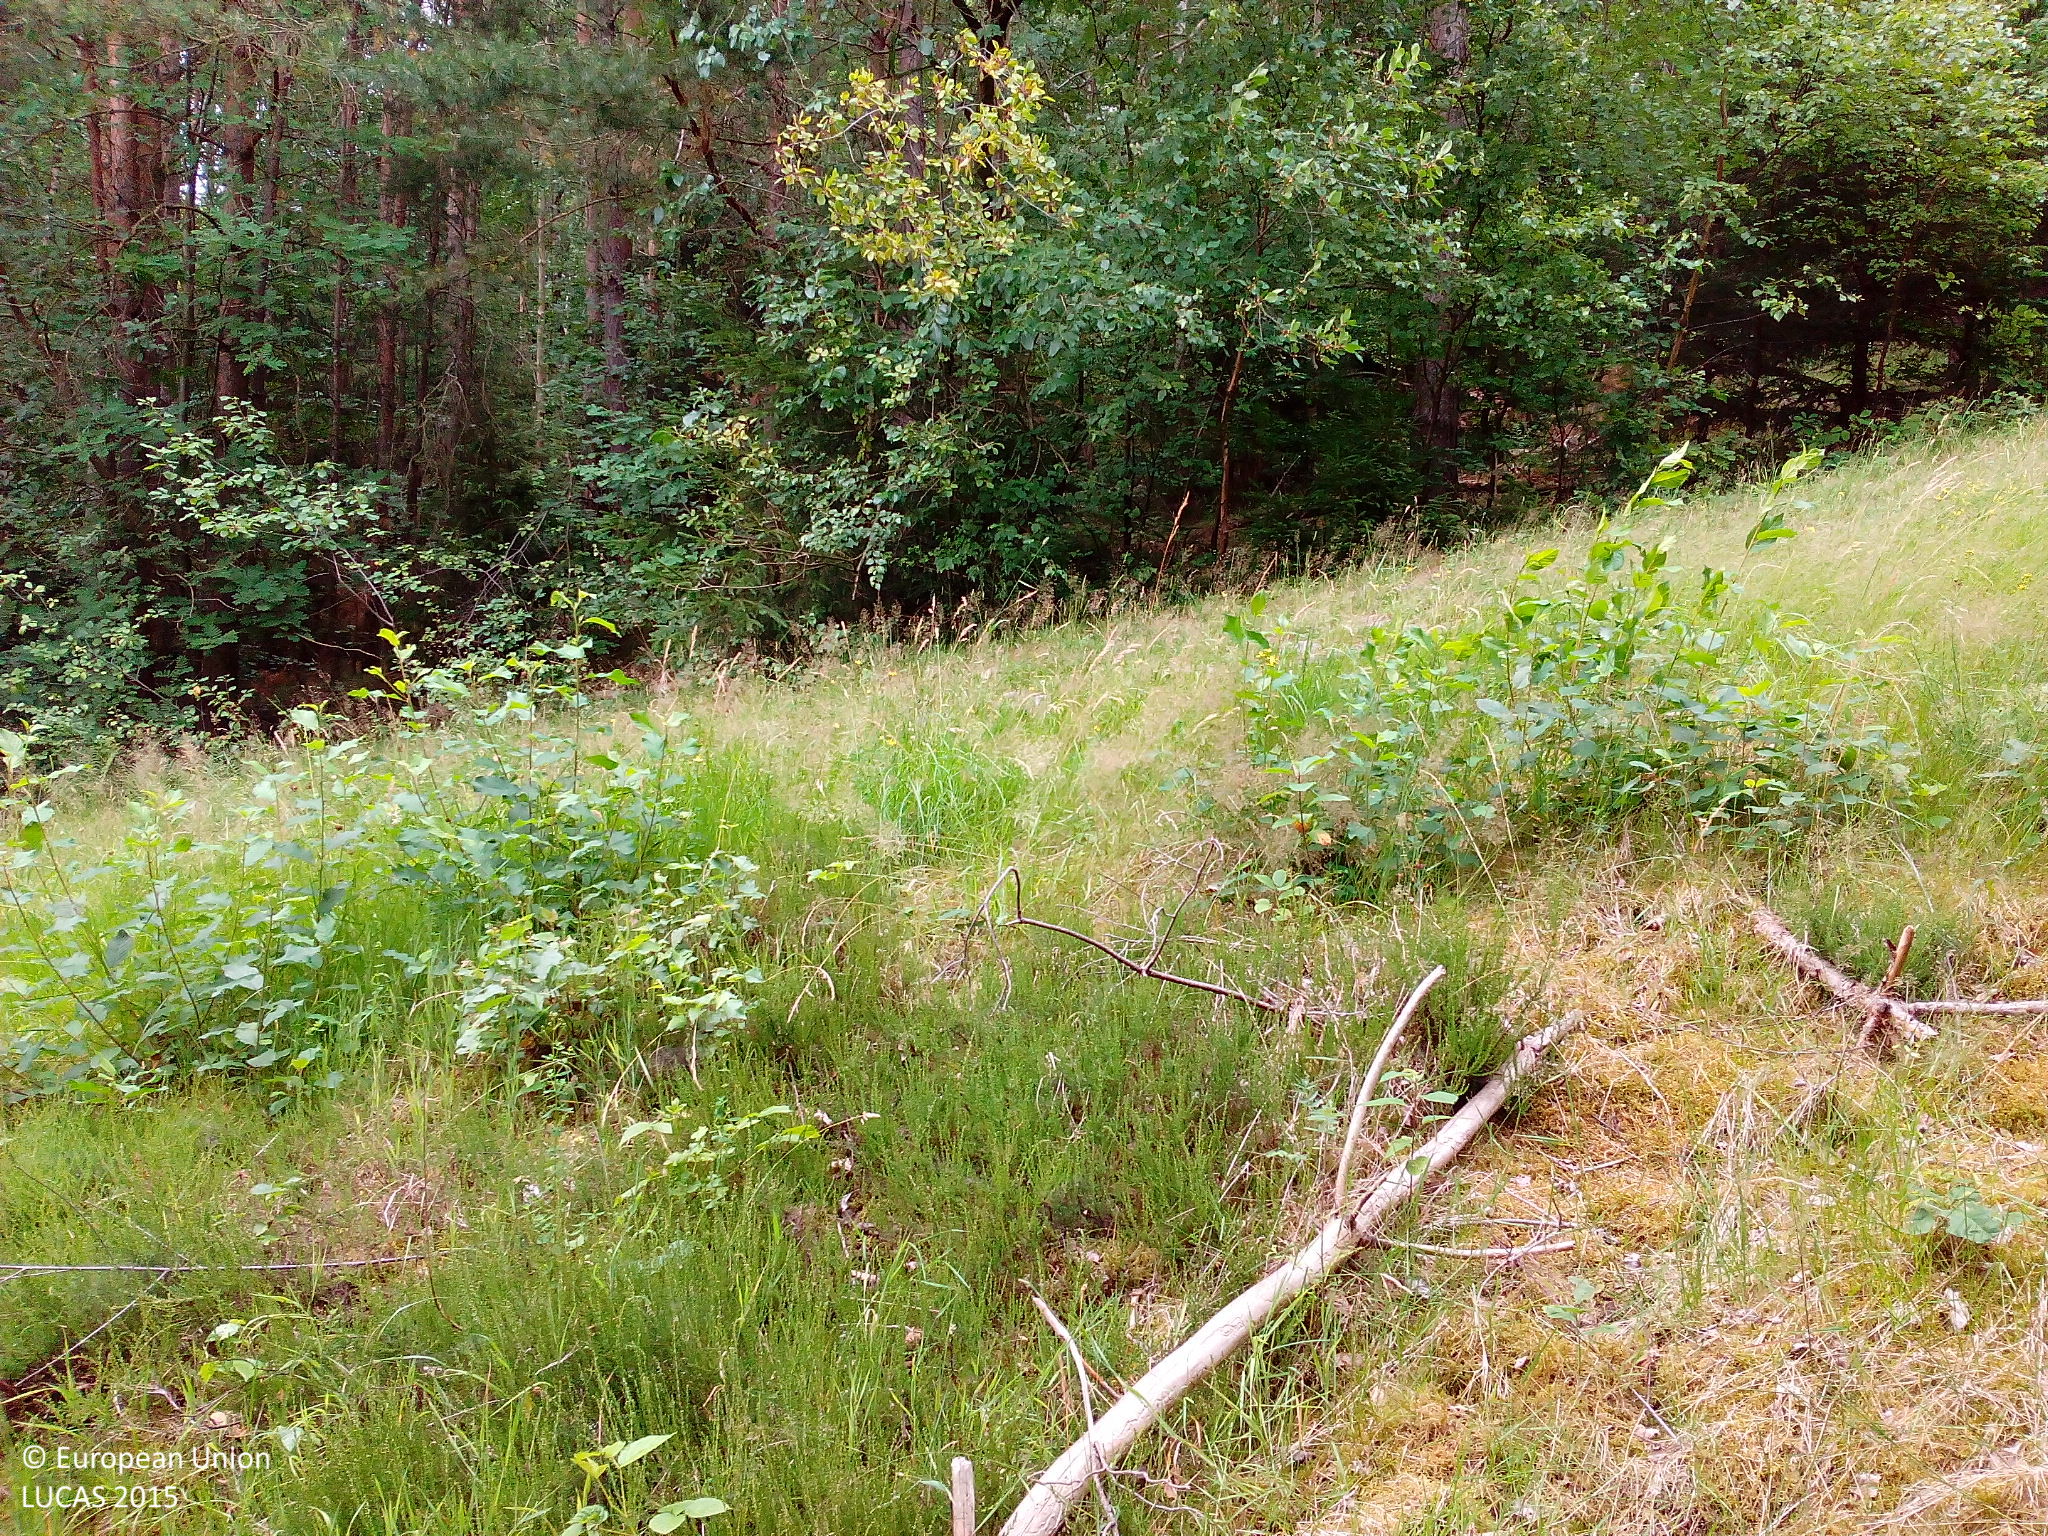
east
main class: Woodland
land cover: Spruce dominated mixed woodland
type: hemiboreal forest and nemoral coniferous forest and mixed broadleaved-coniferous forest
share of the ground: > 75 %
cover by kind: coniferous forest trees 60 %, broadleaved forest trees 40 %
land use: Forestry
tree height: > 5 m
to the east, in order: Spruce dominated mixed woodland; Grassland without tree/shrub cover; Spruce dominated mixed woodland; Tracks; Pine dominated mixed woodland; Spruce dominated mixed woodland; Broadleaved woodland; Tracks; Broadleaved woodland
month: July
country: DE
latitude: 50.8135
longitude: 9.9574
